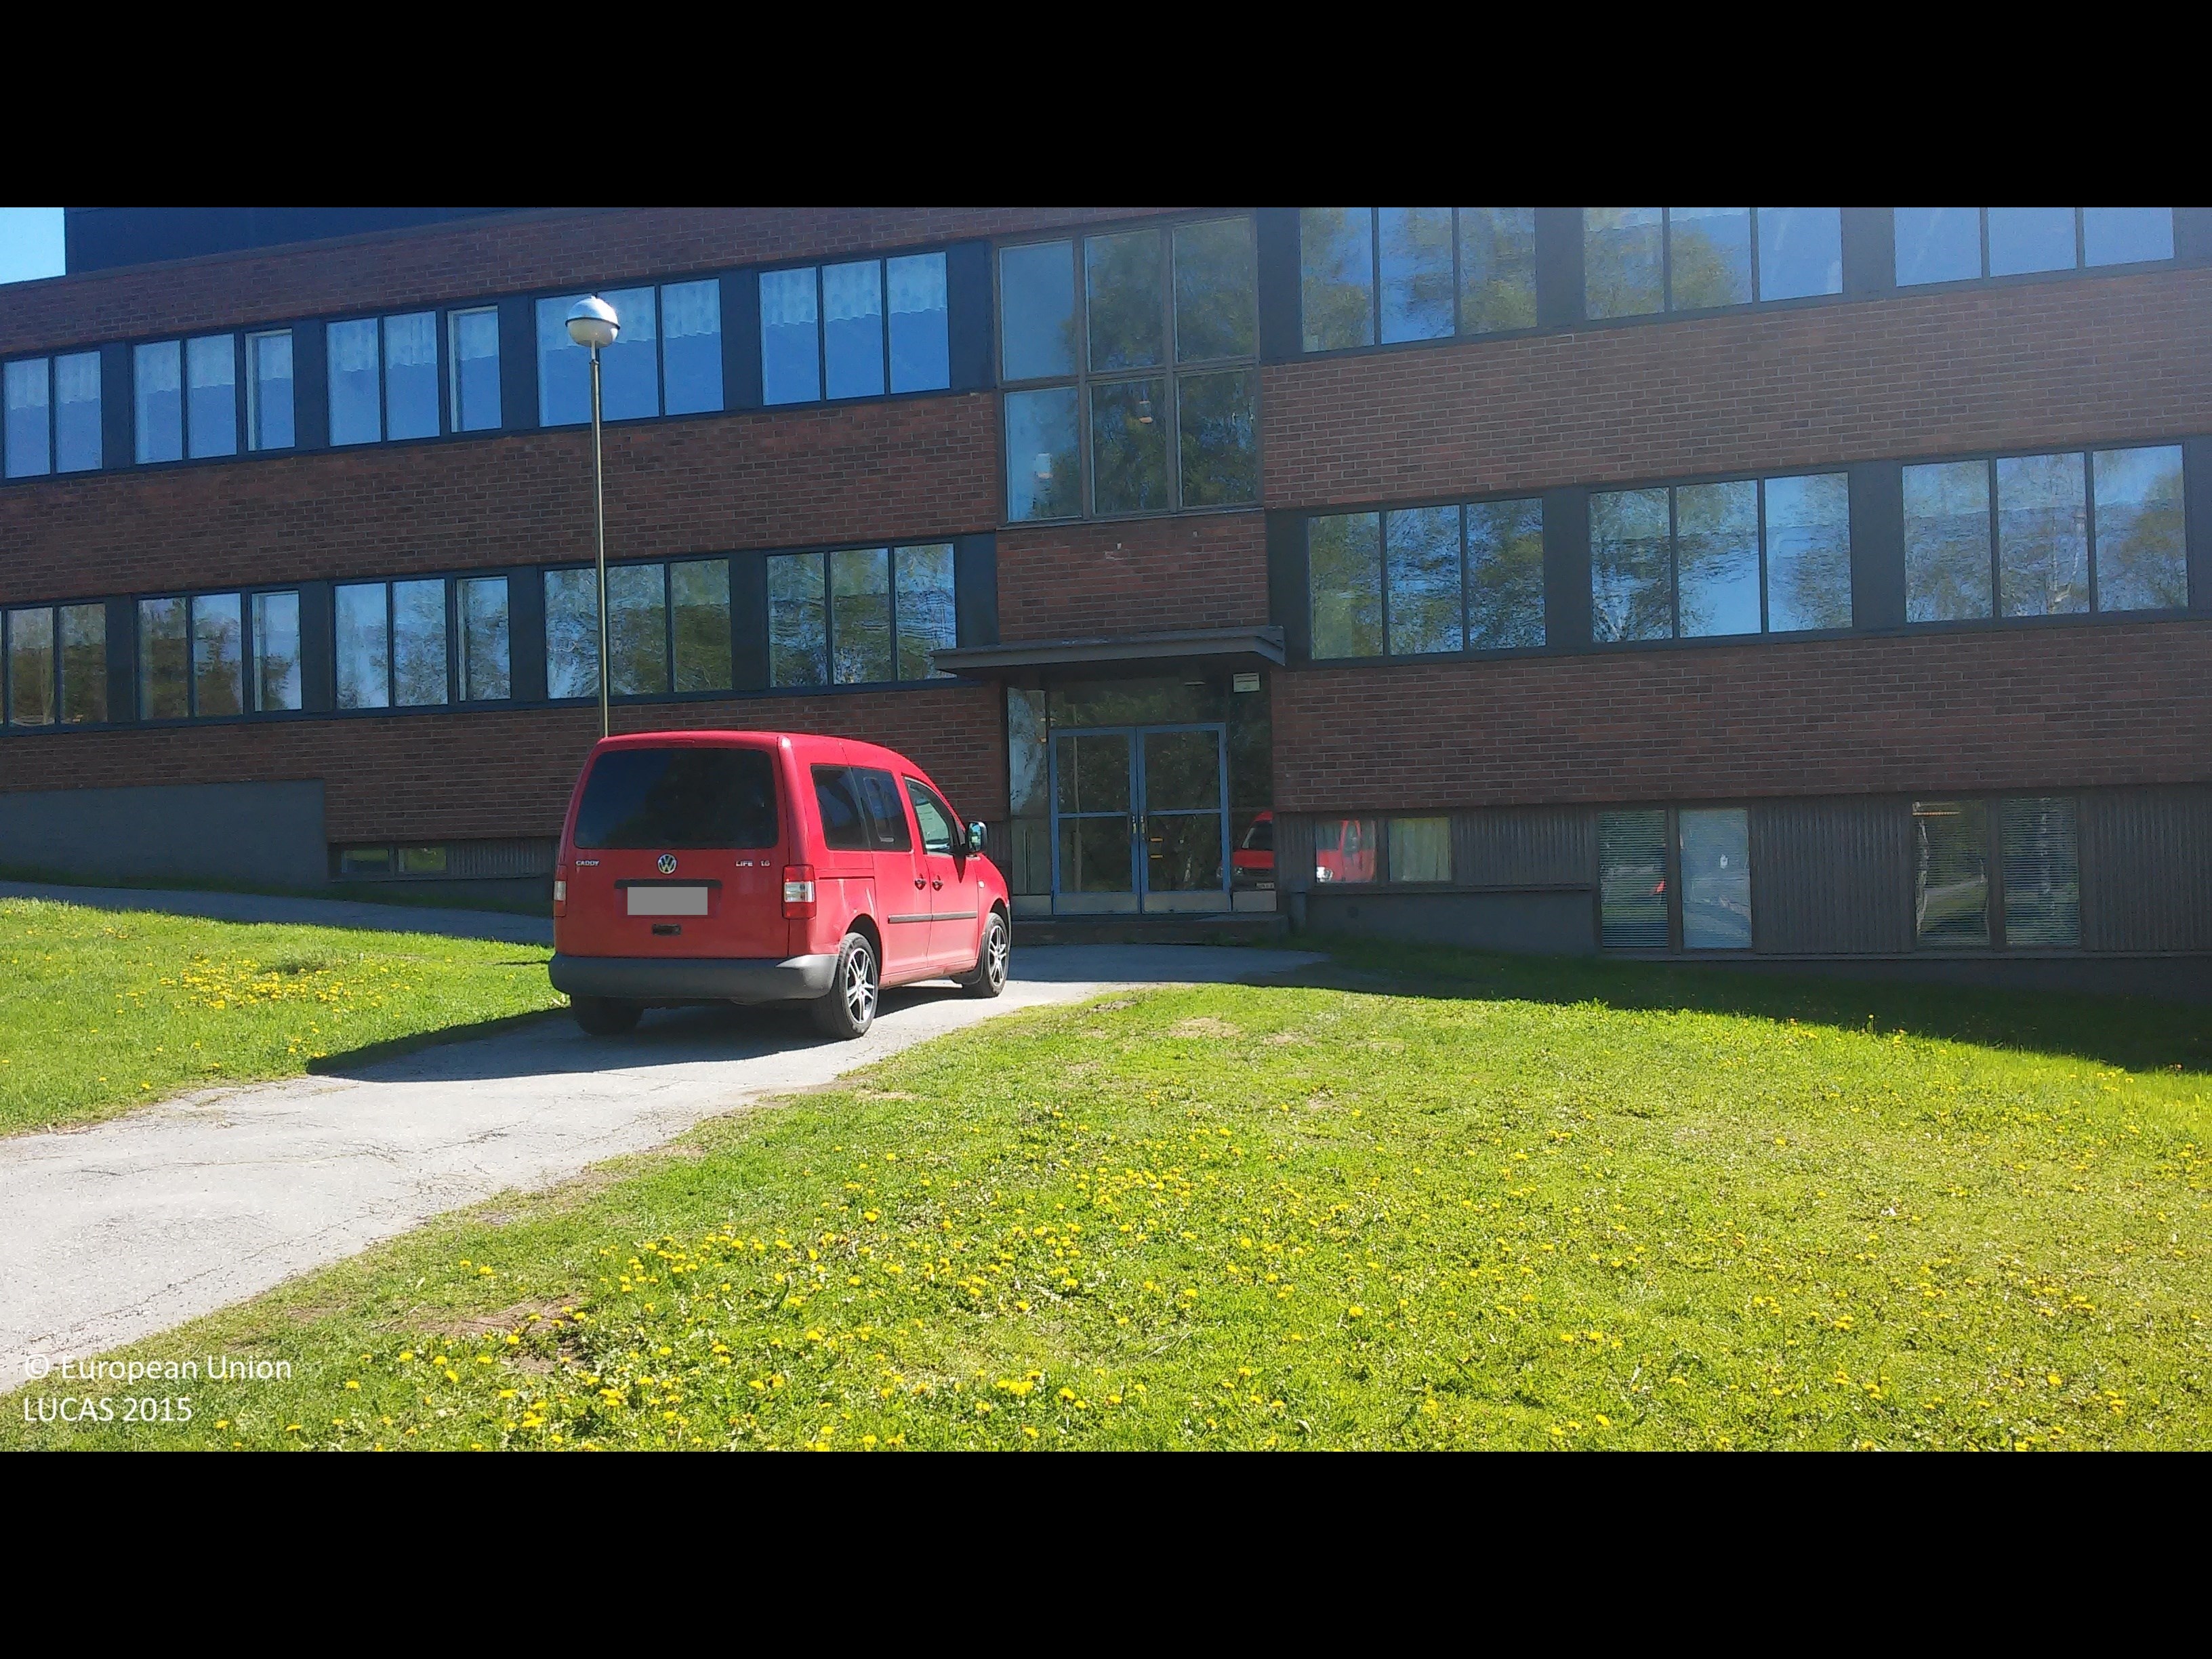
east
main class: Grassland
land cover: Grassland with sparse tree/shrub cover
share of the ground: > 75 %
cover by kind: herbaceous plants 95 %, broadleaved forest trees 5 %
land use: Community services
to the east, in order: Grassland with sparse tree/shrub cover; Artificial constructions in urban areas
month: June
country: FI
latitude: 63.7296
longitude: 23.0330
